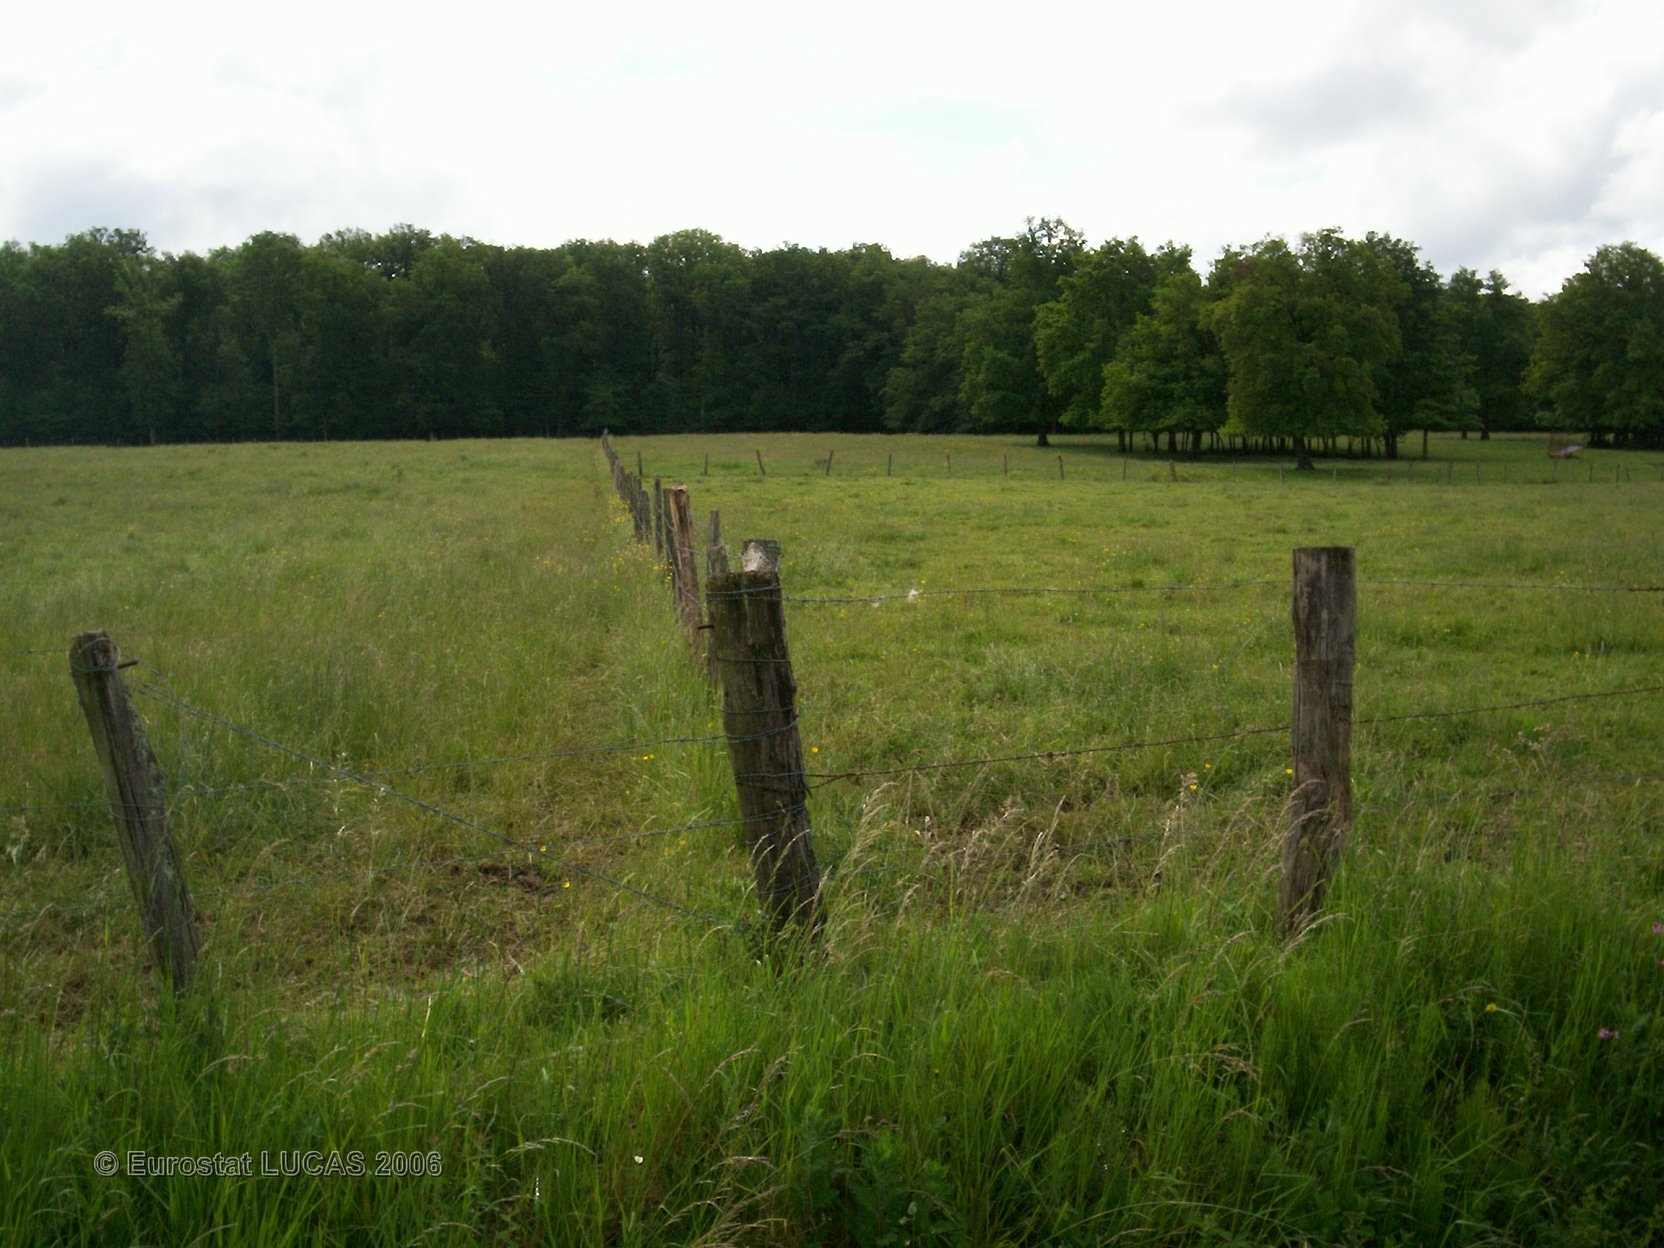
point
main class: Grassland
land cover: Grassland without tree/shrub cover
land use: Agriculture (excluding fallow land and kitchen gardens)
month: May
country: FR
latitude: 48.3046
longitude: 4.5374
